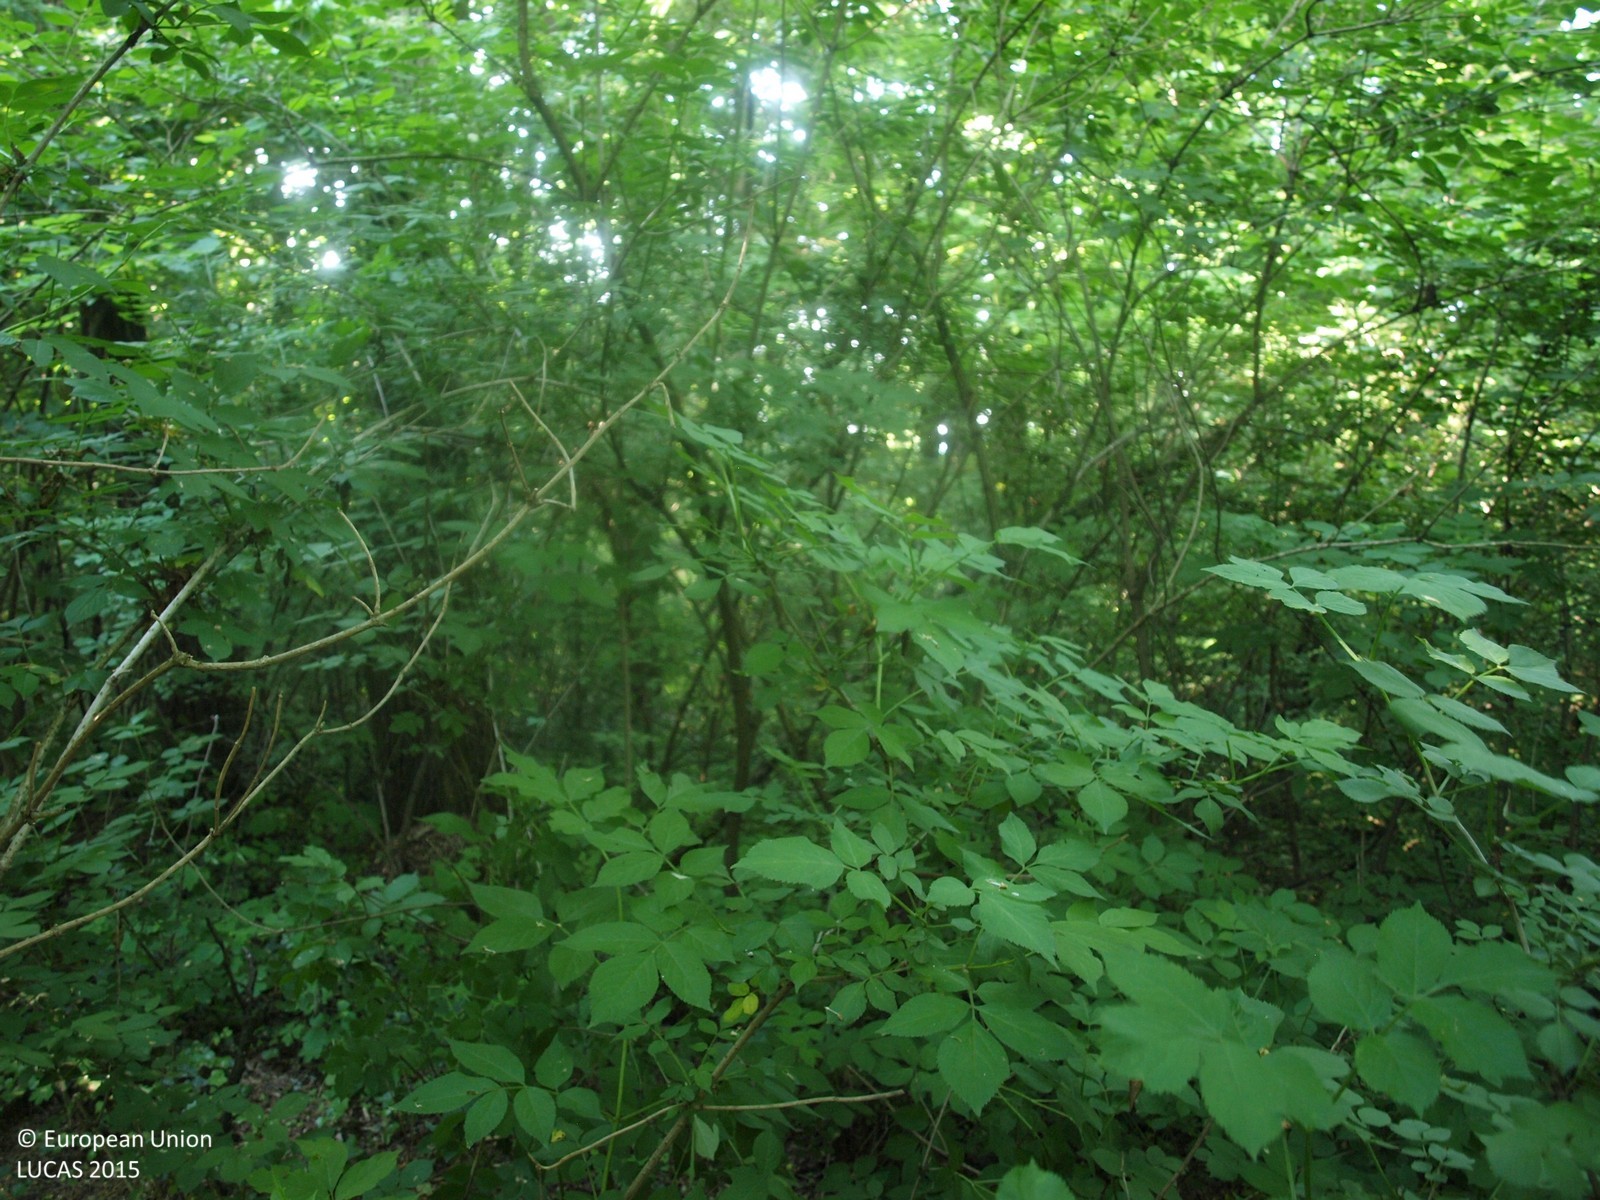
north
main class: Woodland
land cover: Broadleaved woodland
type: mesophytic deciduous forest
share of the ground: > 75 %
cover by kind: broadleaved forest trees 100 %
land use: Forestry
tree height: > 5 m
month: June
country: HR
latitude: 46.2997
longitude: 16.1664
